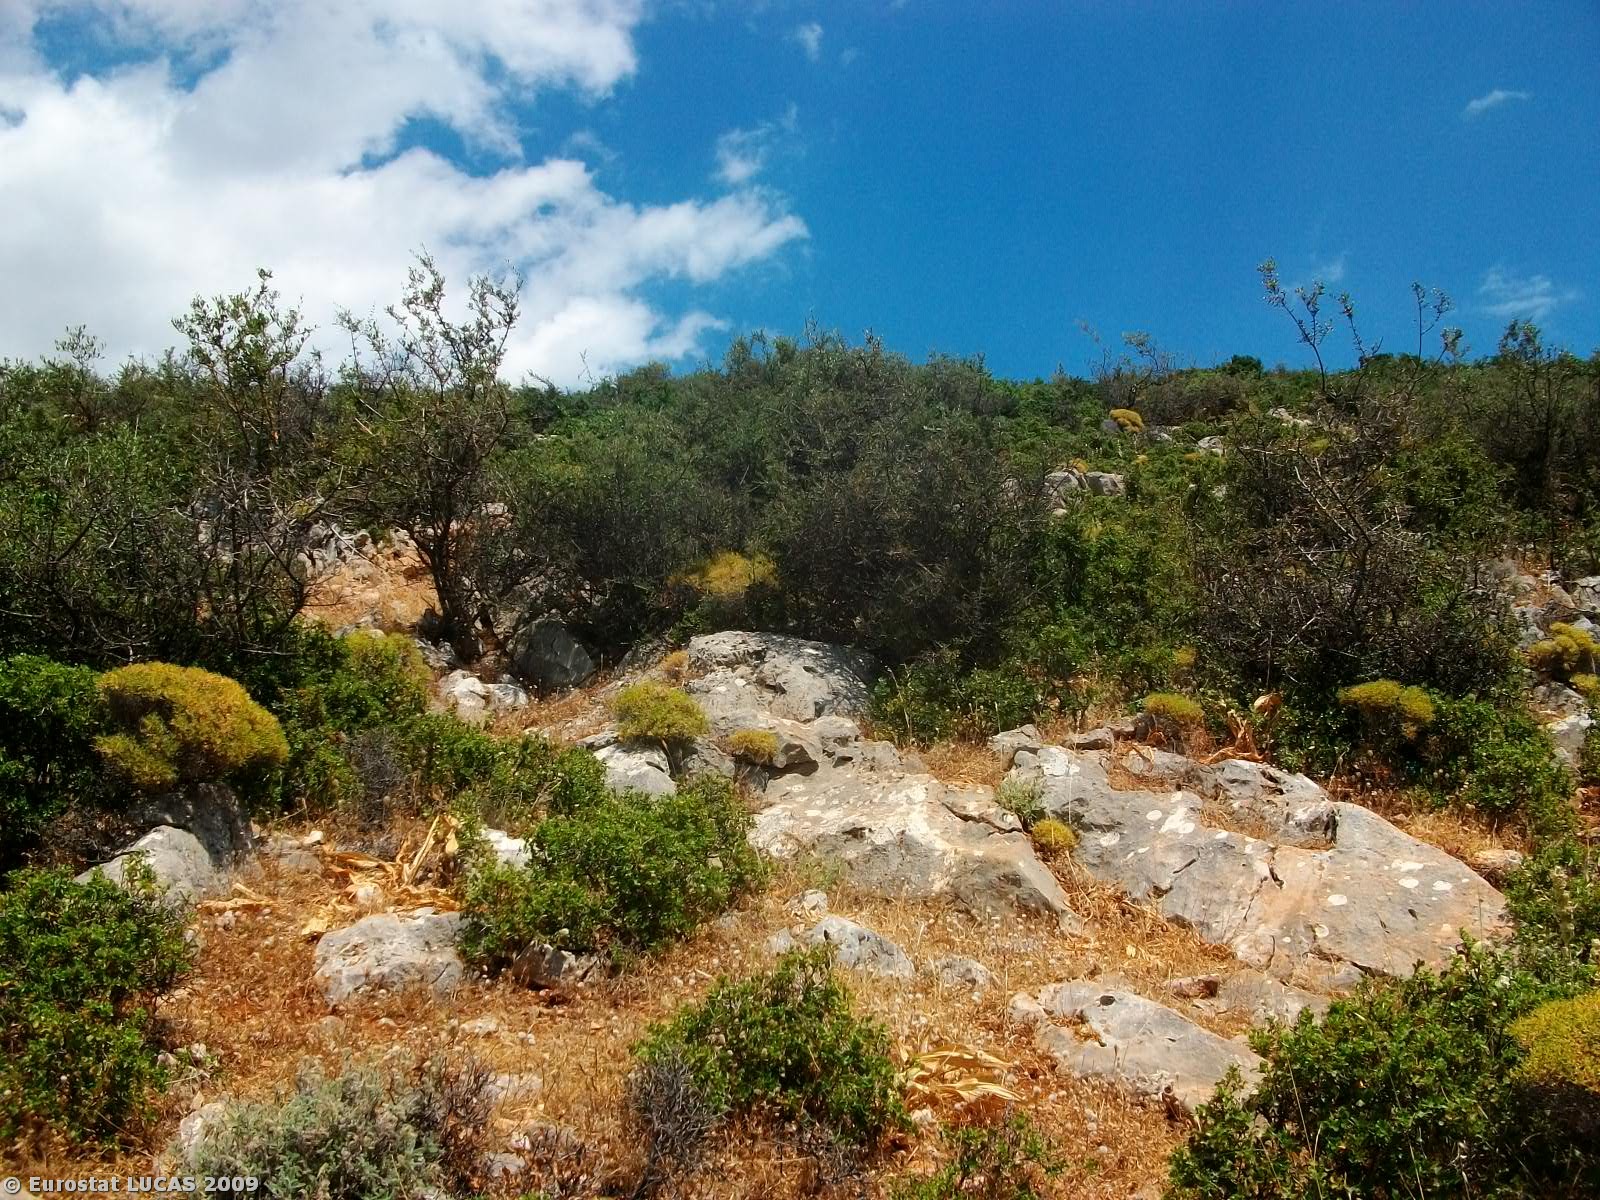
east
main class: Shrubland
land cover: Shrubland without tree cover
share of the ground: > 75 %
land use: Agriculture (excluding fallow land and kitchen gardens)
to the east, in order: Shrubland without tree cover
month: June
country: GR
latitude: 38.2365
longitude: 23.0588
